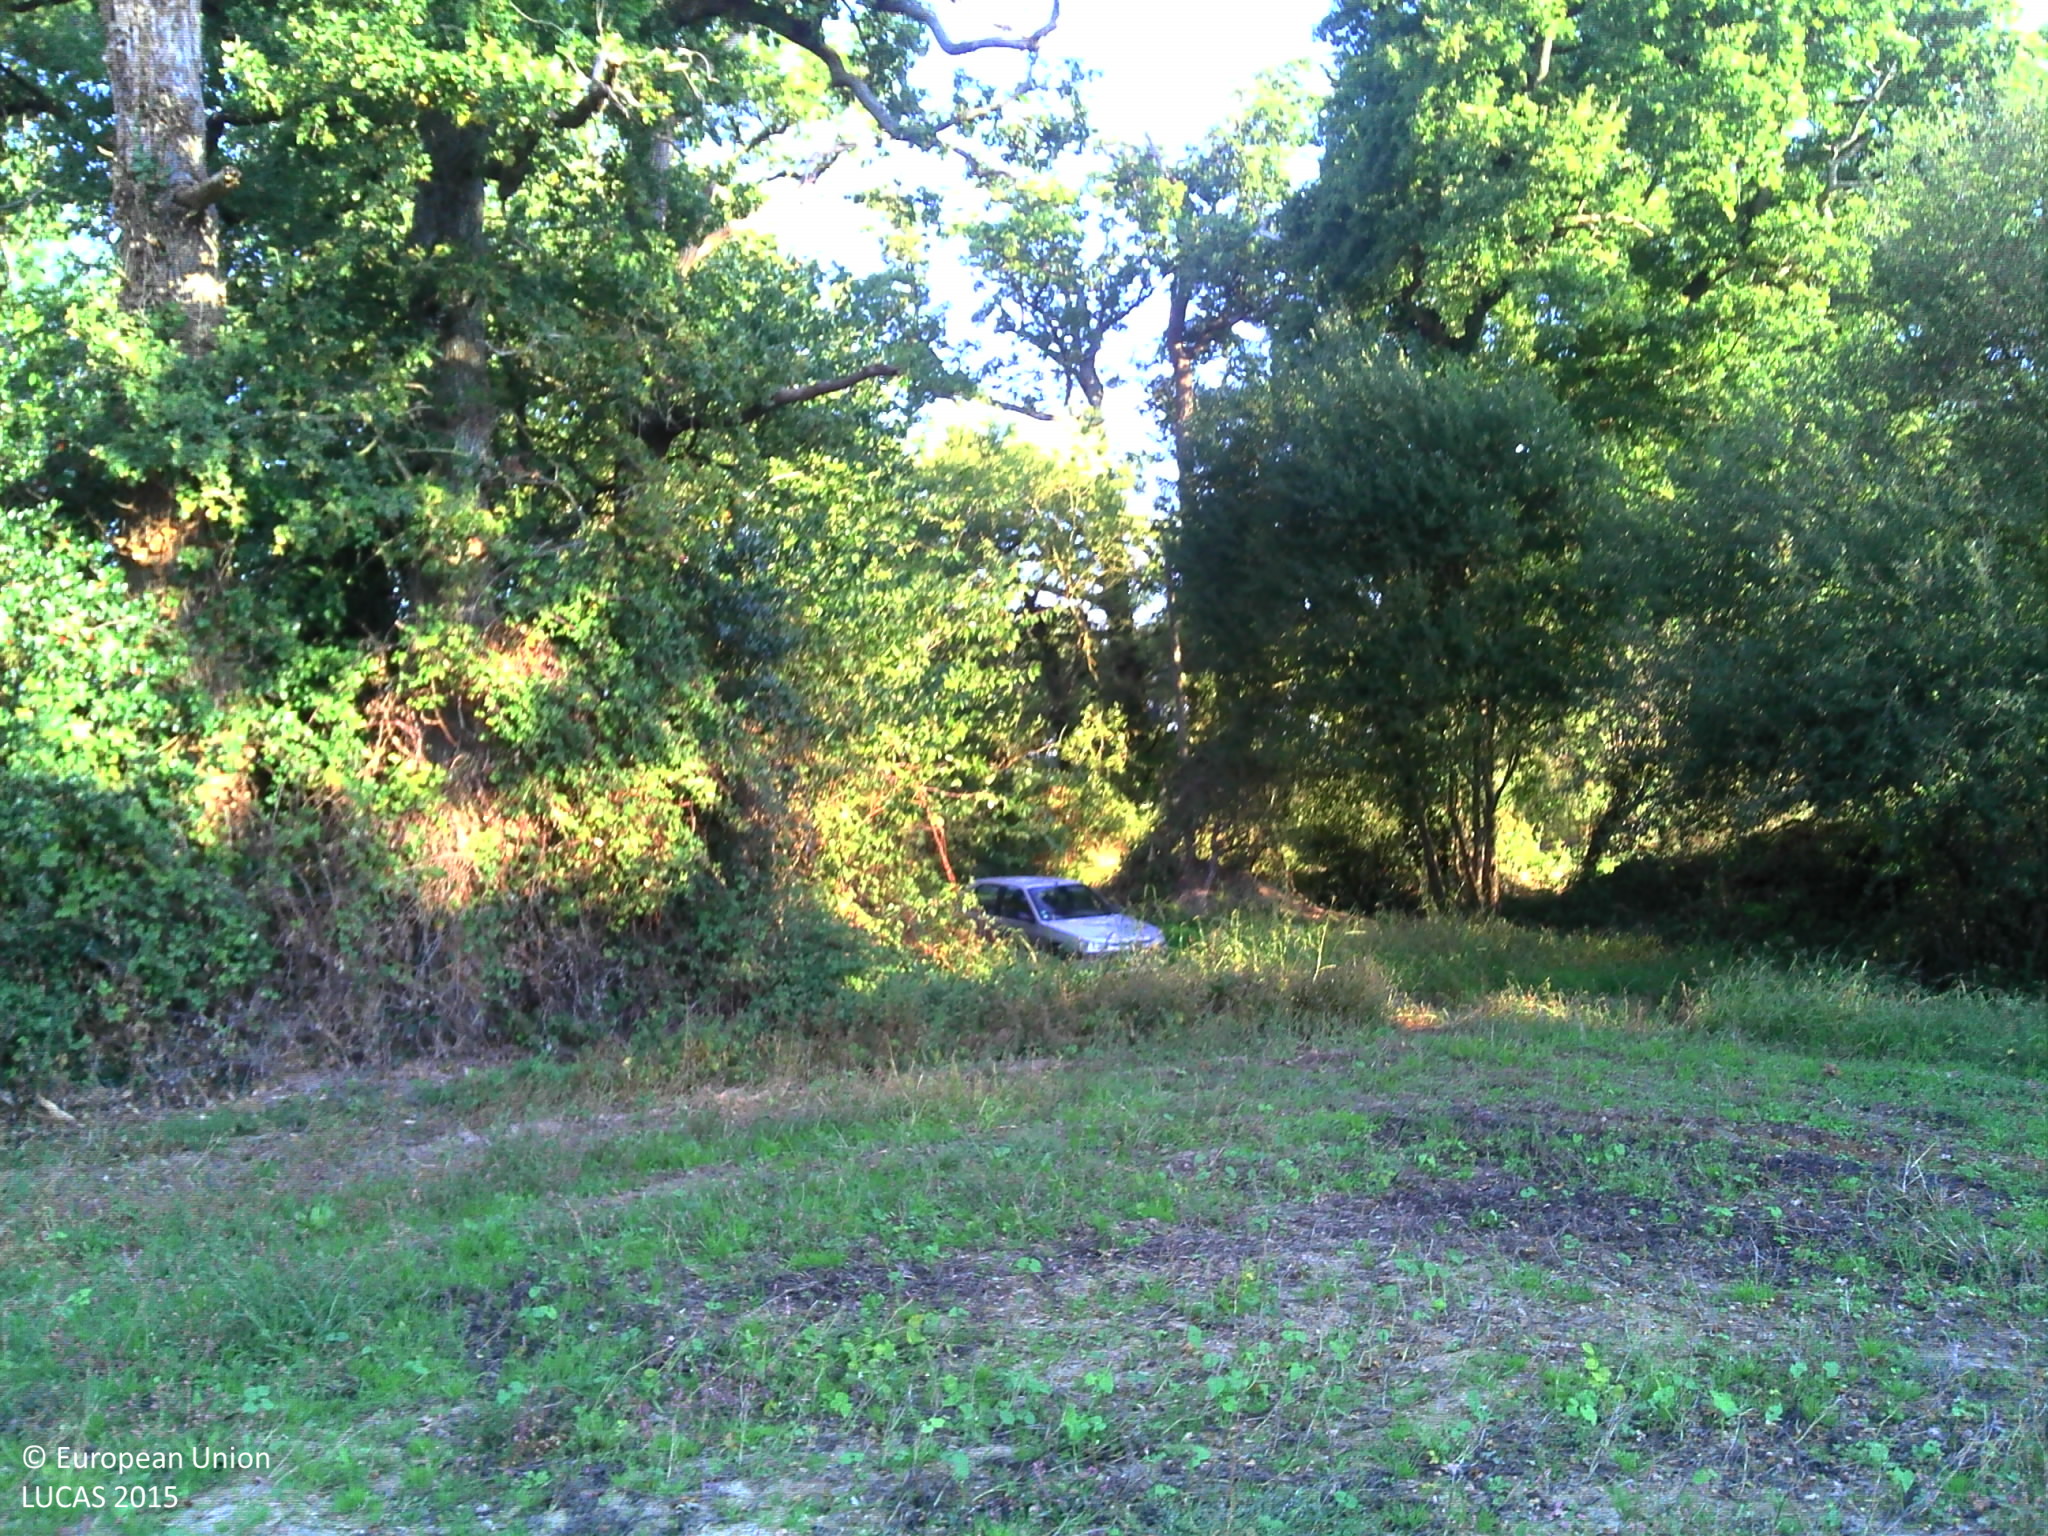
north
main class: Cropland
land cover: Dry pulses
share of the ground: 10 - 25 %
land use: Agriculture (excluding fallow land and kitchen gardens)
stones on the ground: < 10 %
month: September
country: FR
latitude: 46.6083
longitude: -1.0920
